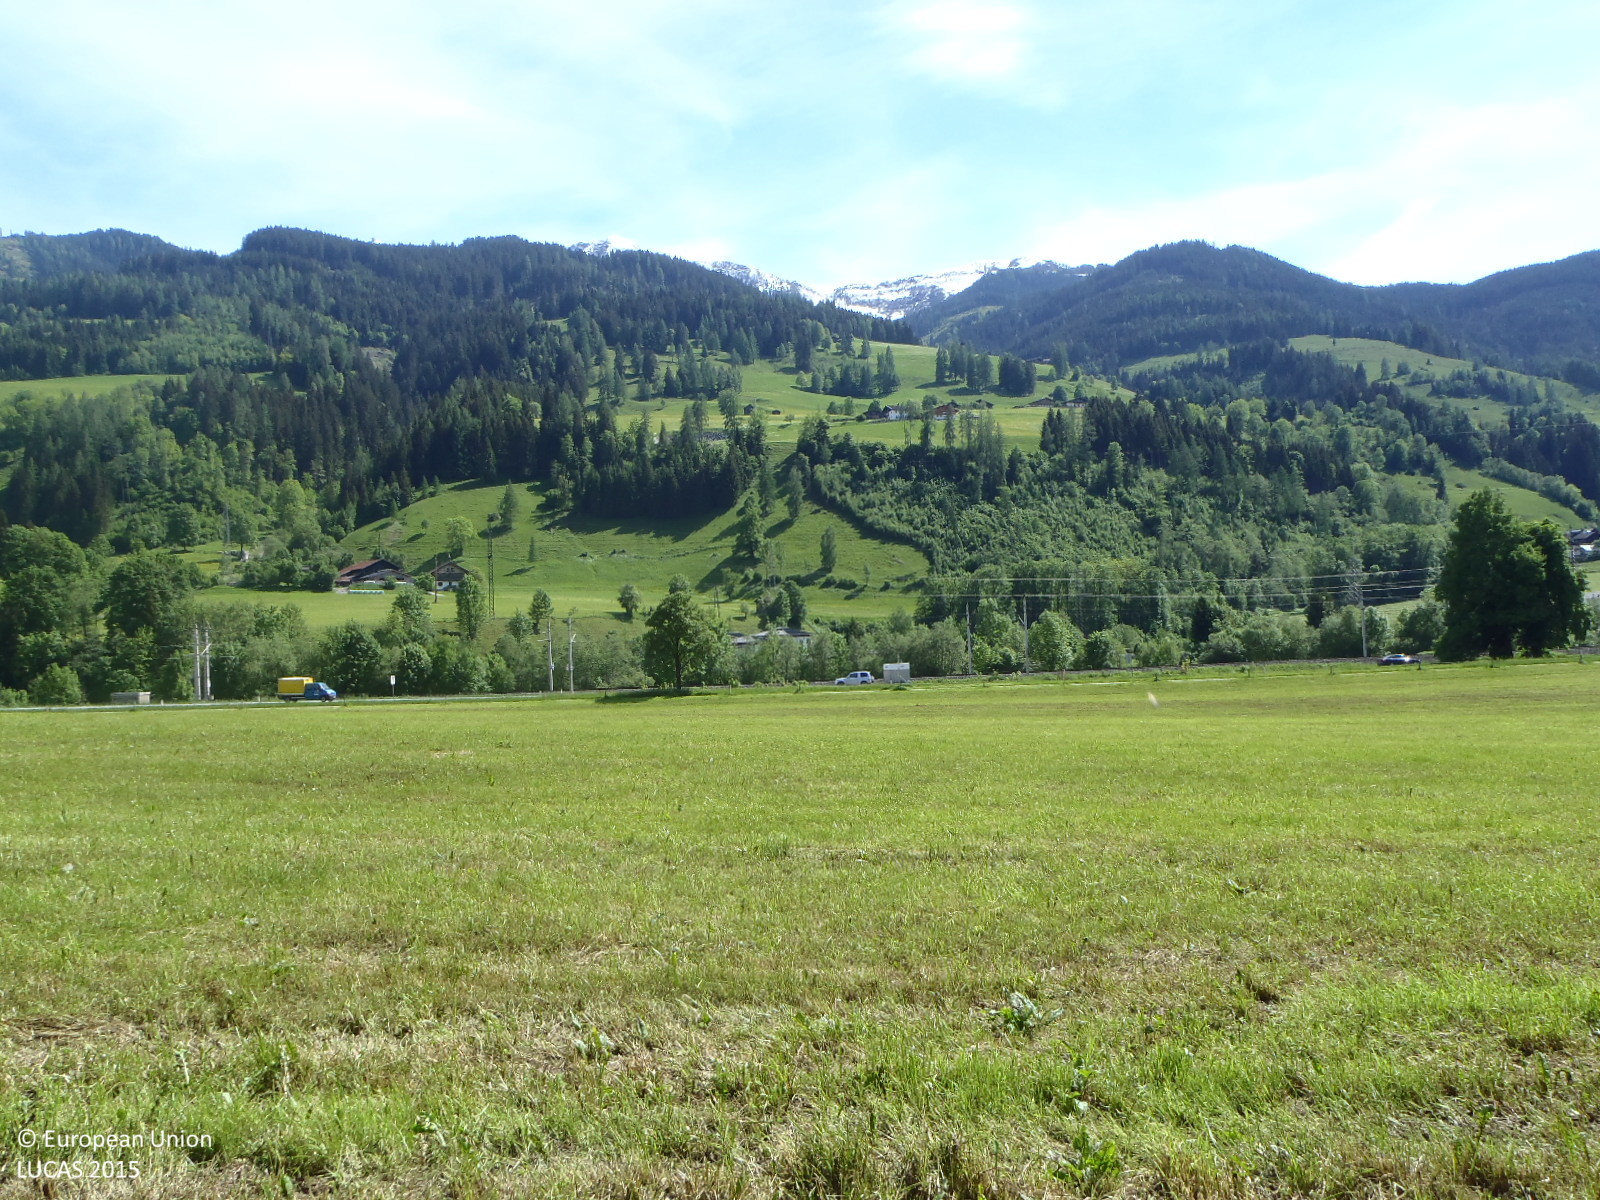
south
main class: Grassland
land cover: Grassland without tree/shrub cover
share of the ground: > 75 %
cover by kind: herbaceous plants 80 %, unconsolidated bare surface 20 %
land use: Agriculture (excluding fallow land and kitchen gardens)
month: May
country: AT
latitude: 47.2858
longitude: 12.8671
